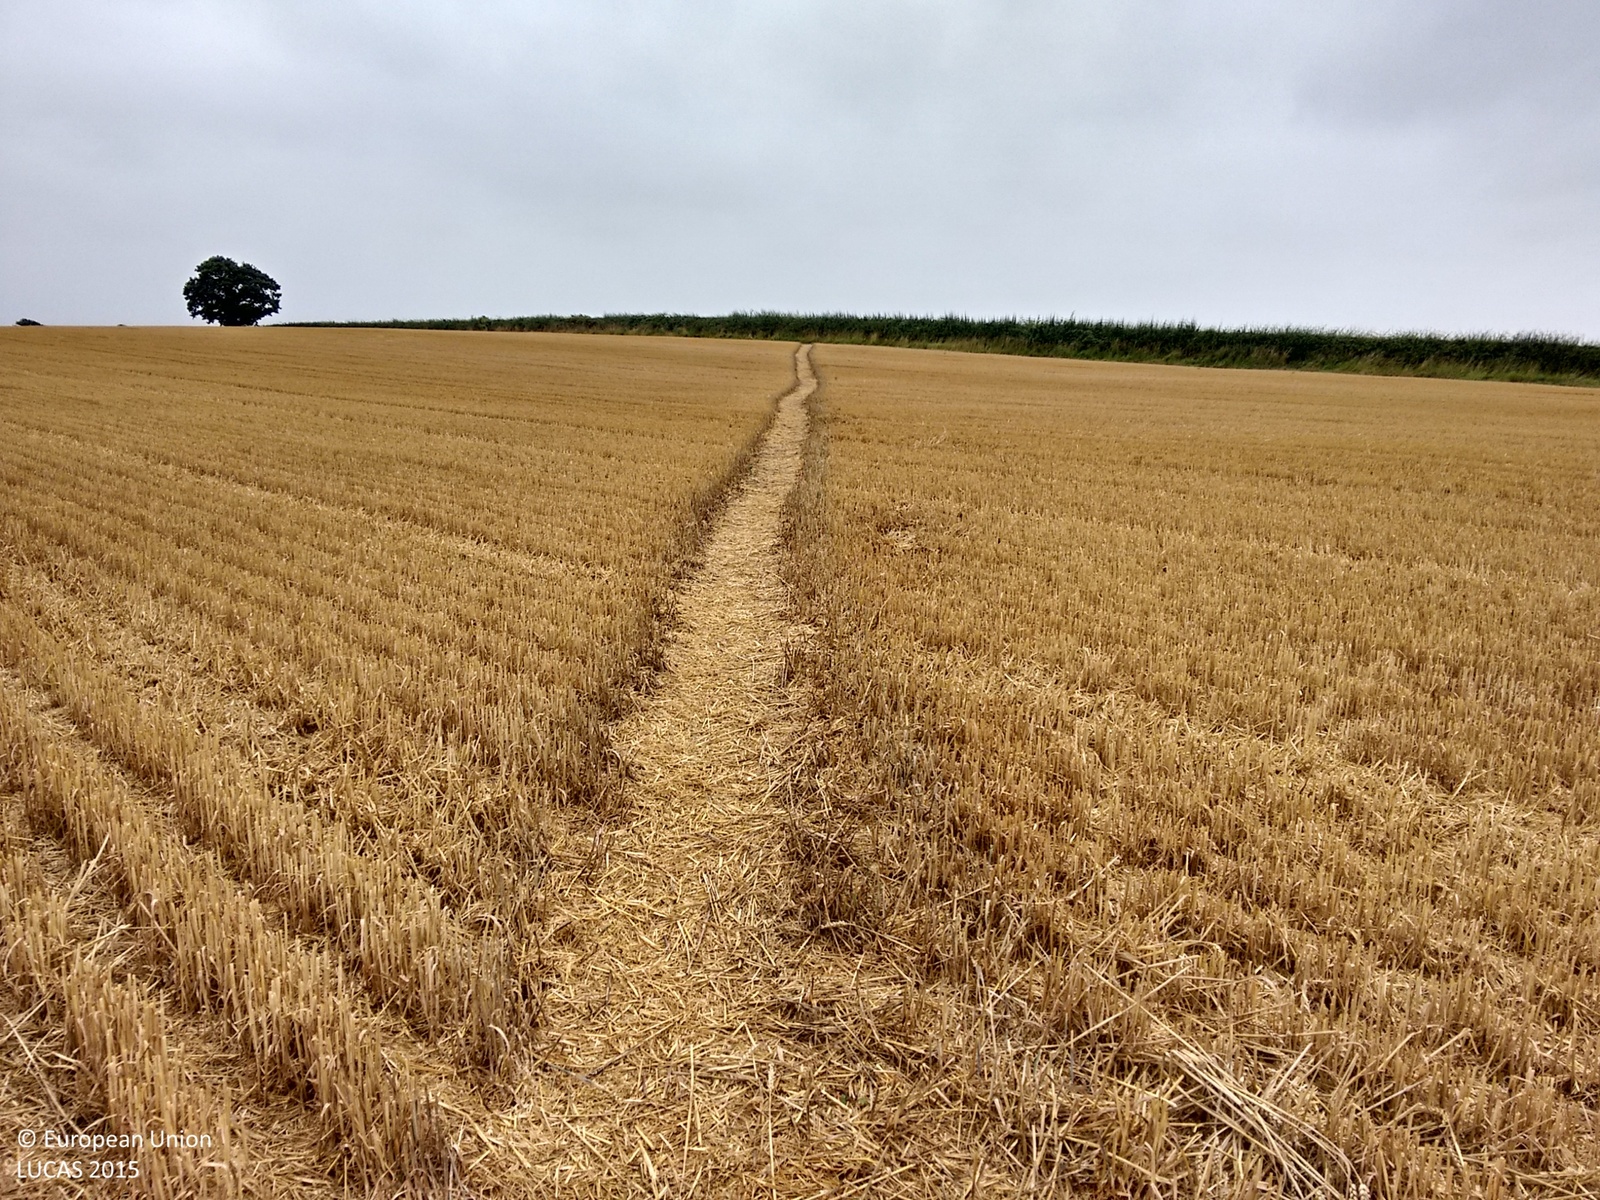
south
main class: Cropland
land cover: Common wheat
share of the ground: > 75 %
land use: Agriculture (excluding fallow land and kitchen gardens)
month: August
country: GB
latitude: 52.6068
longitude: -1.4051
